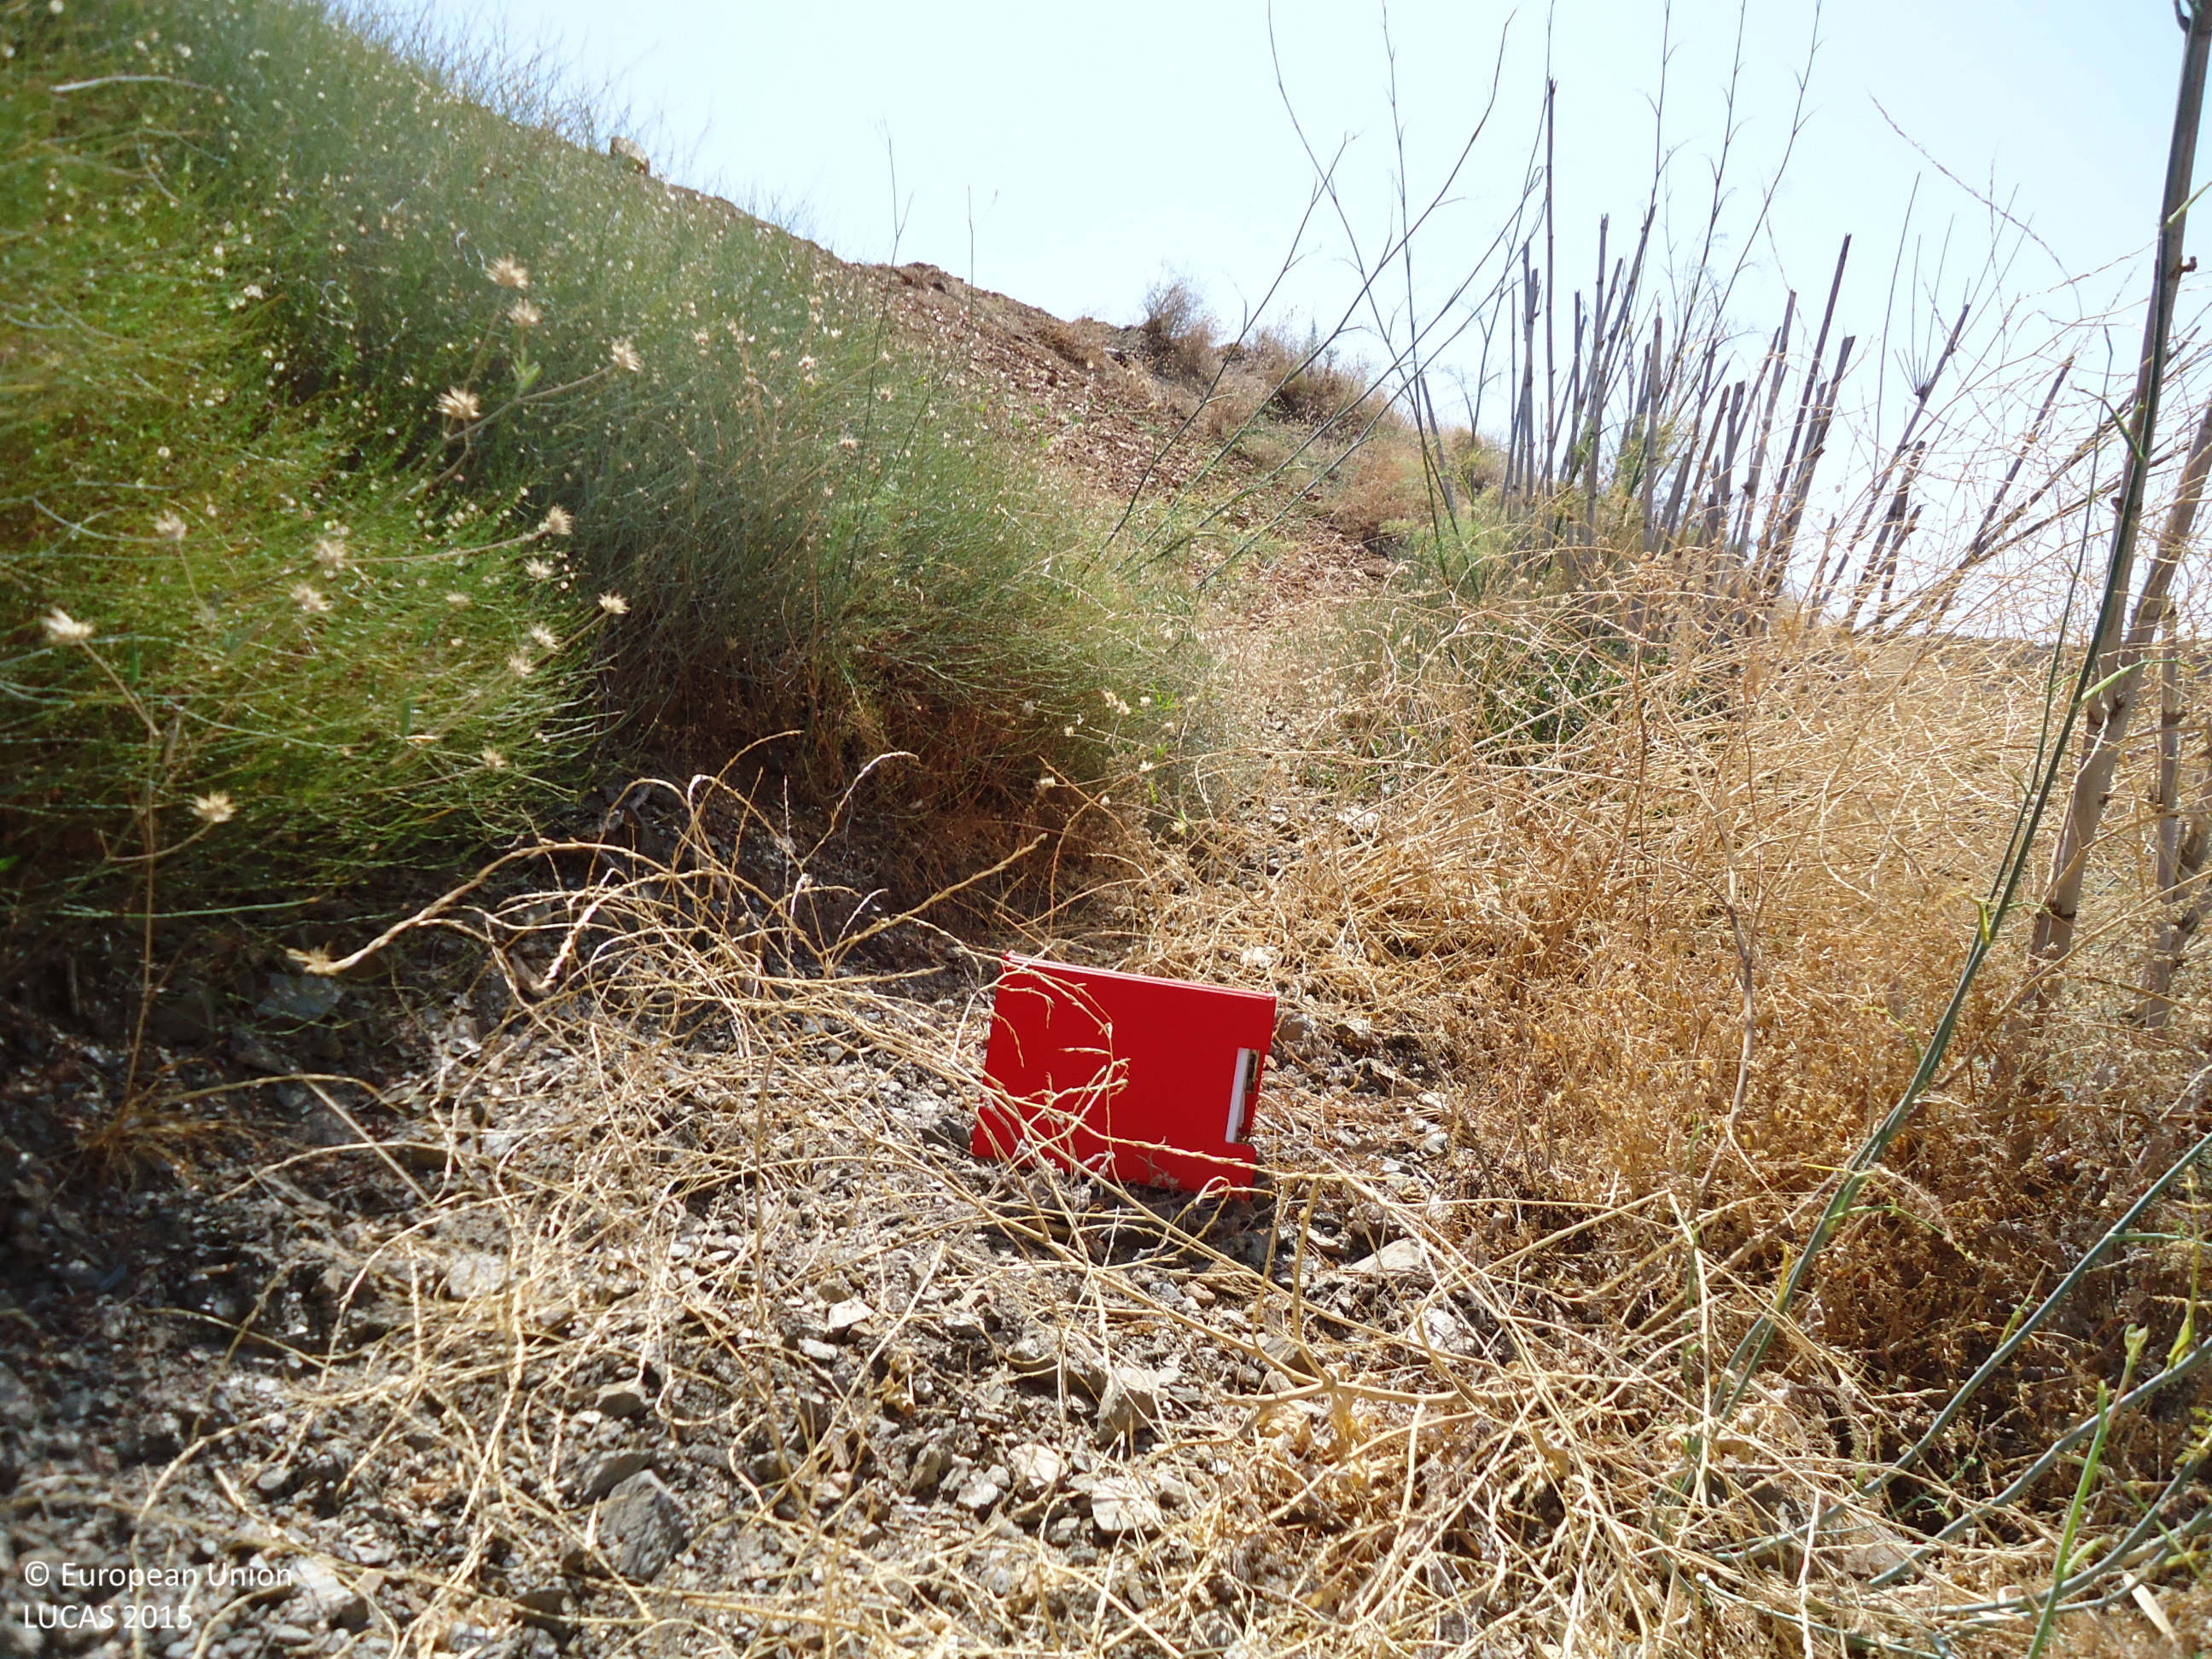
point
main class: Grassland
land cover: Grassland without tree/shrub cover
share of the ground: > 75 %
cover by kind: herbaceous plants 90 %, unconsolidated bare surface 10 %
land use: Semi-natural and natural areas not in use
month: July
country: ES
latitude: 36.5251
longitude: -4.6976
